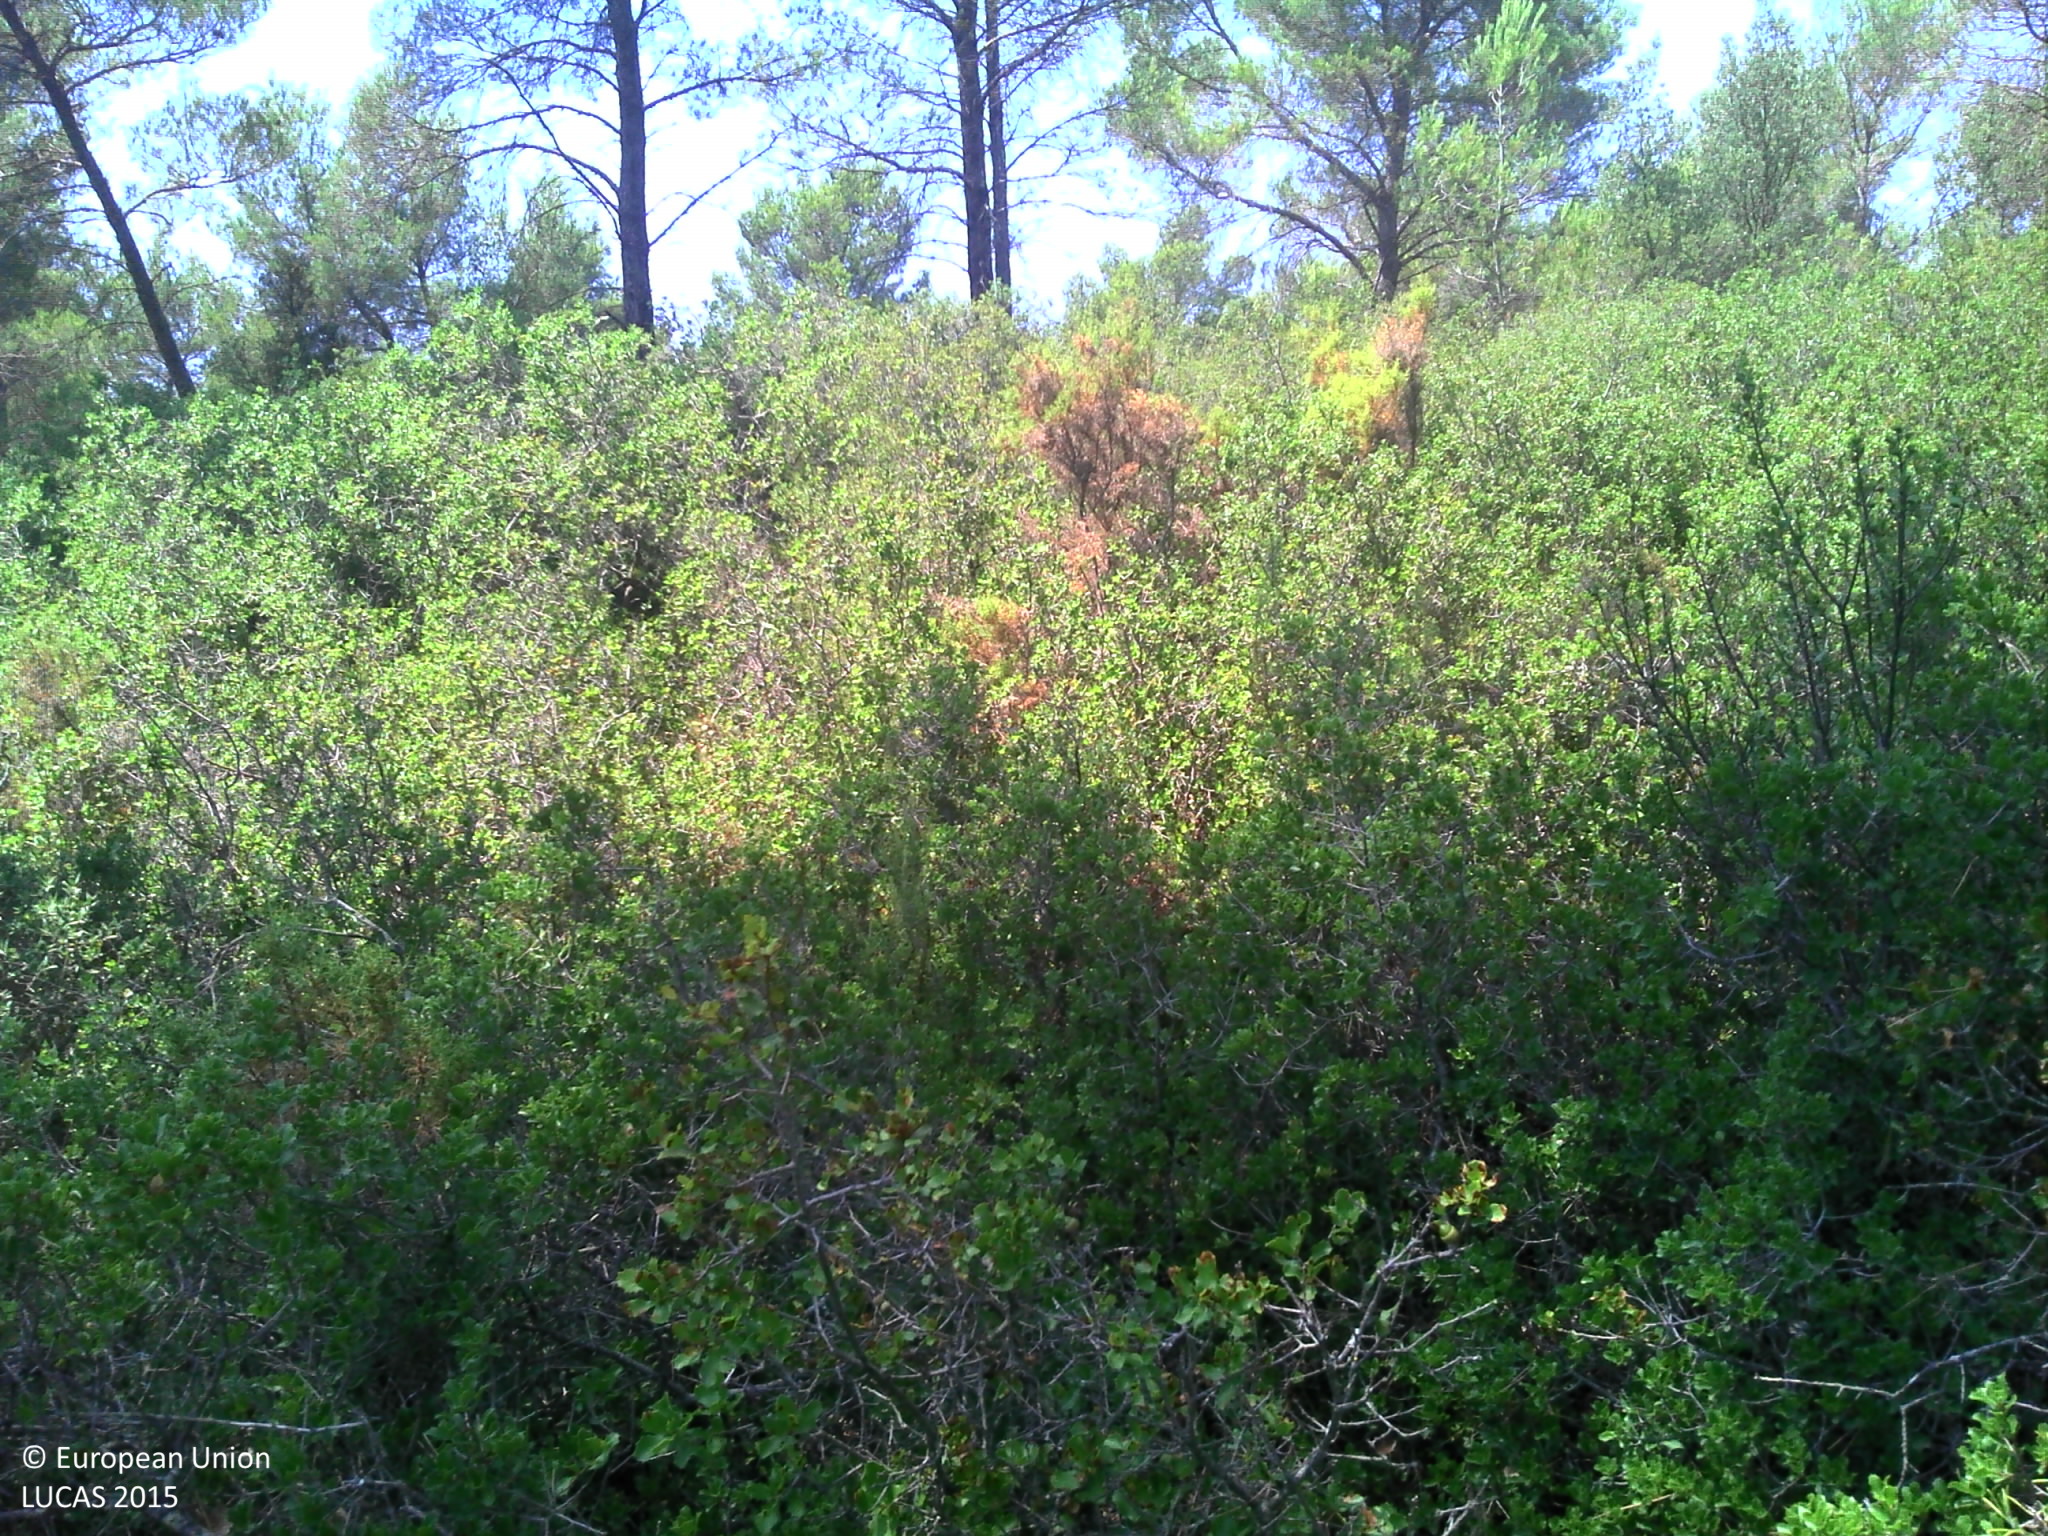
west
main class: Woodland
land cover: Pine dominated coniferous woodland
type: coniferous forest of the mediterranean region
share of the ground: > 75 %
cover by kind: shrubs 60 %, coniferous forest trees 35 %, herbaceous plants 5 %
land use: Semi-natural and natural areas not in use
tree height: > 5 m
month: August
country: FR
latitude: 43.5043
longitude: 5.3222
